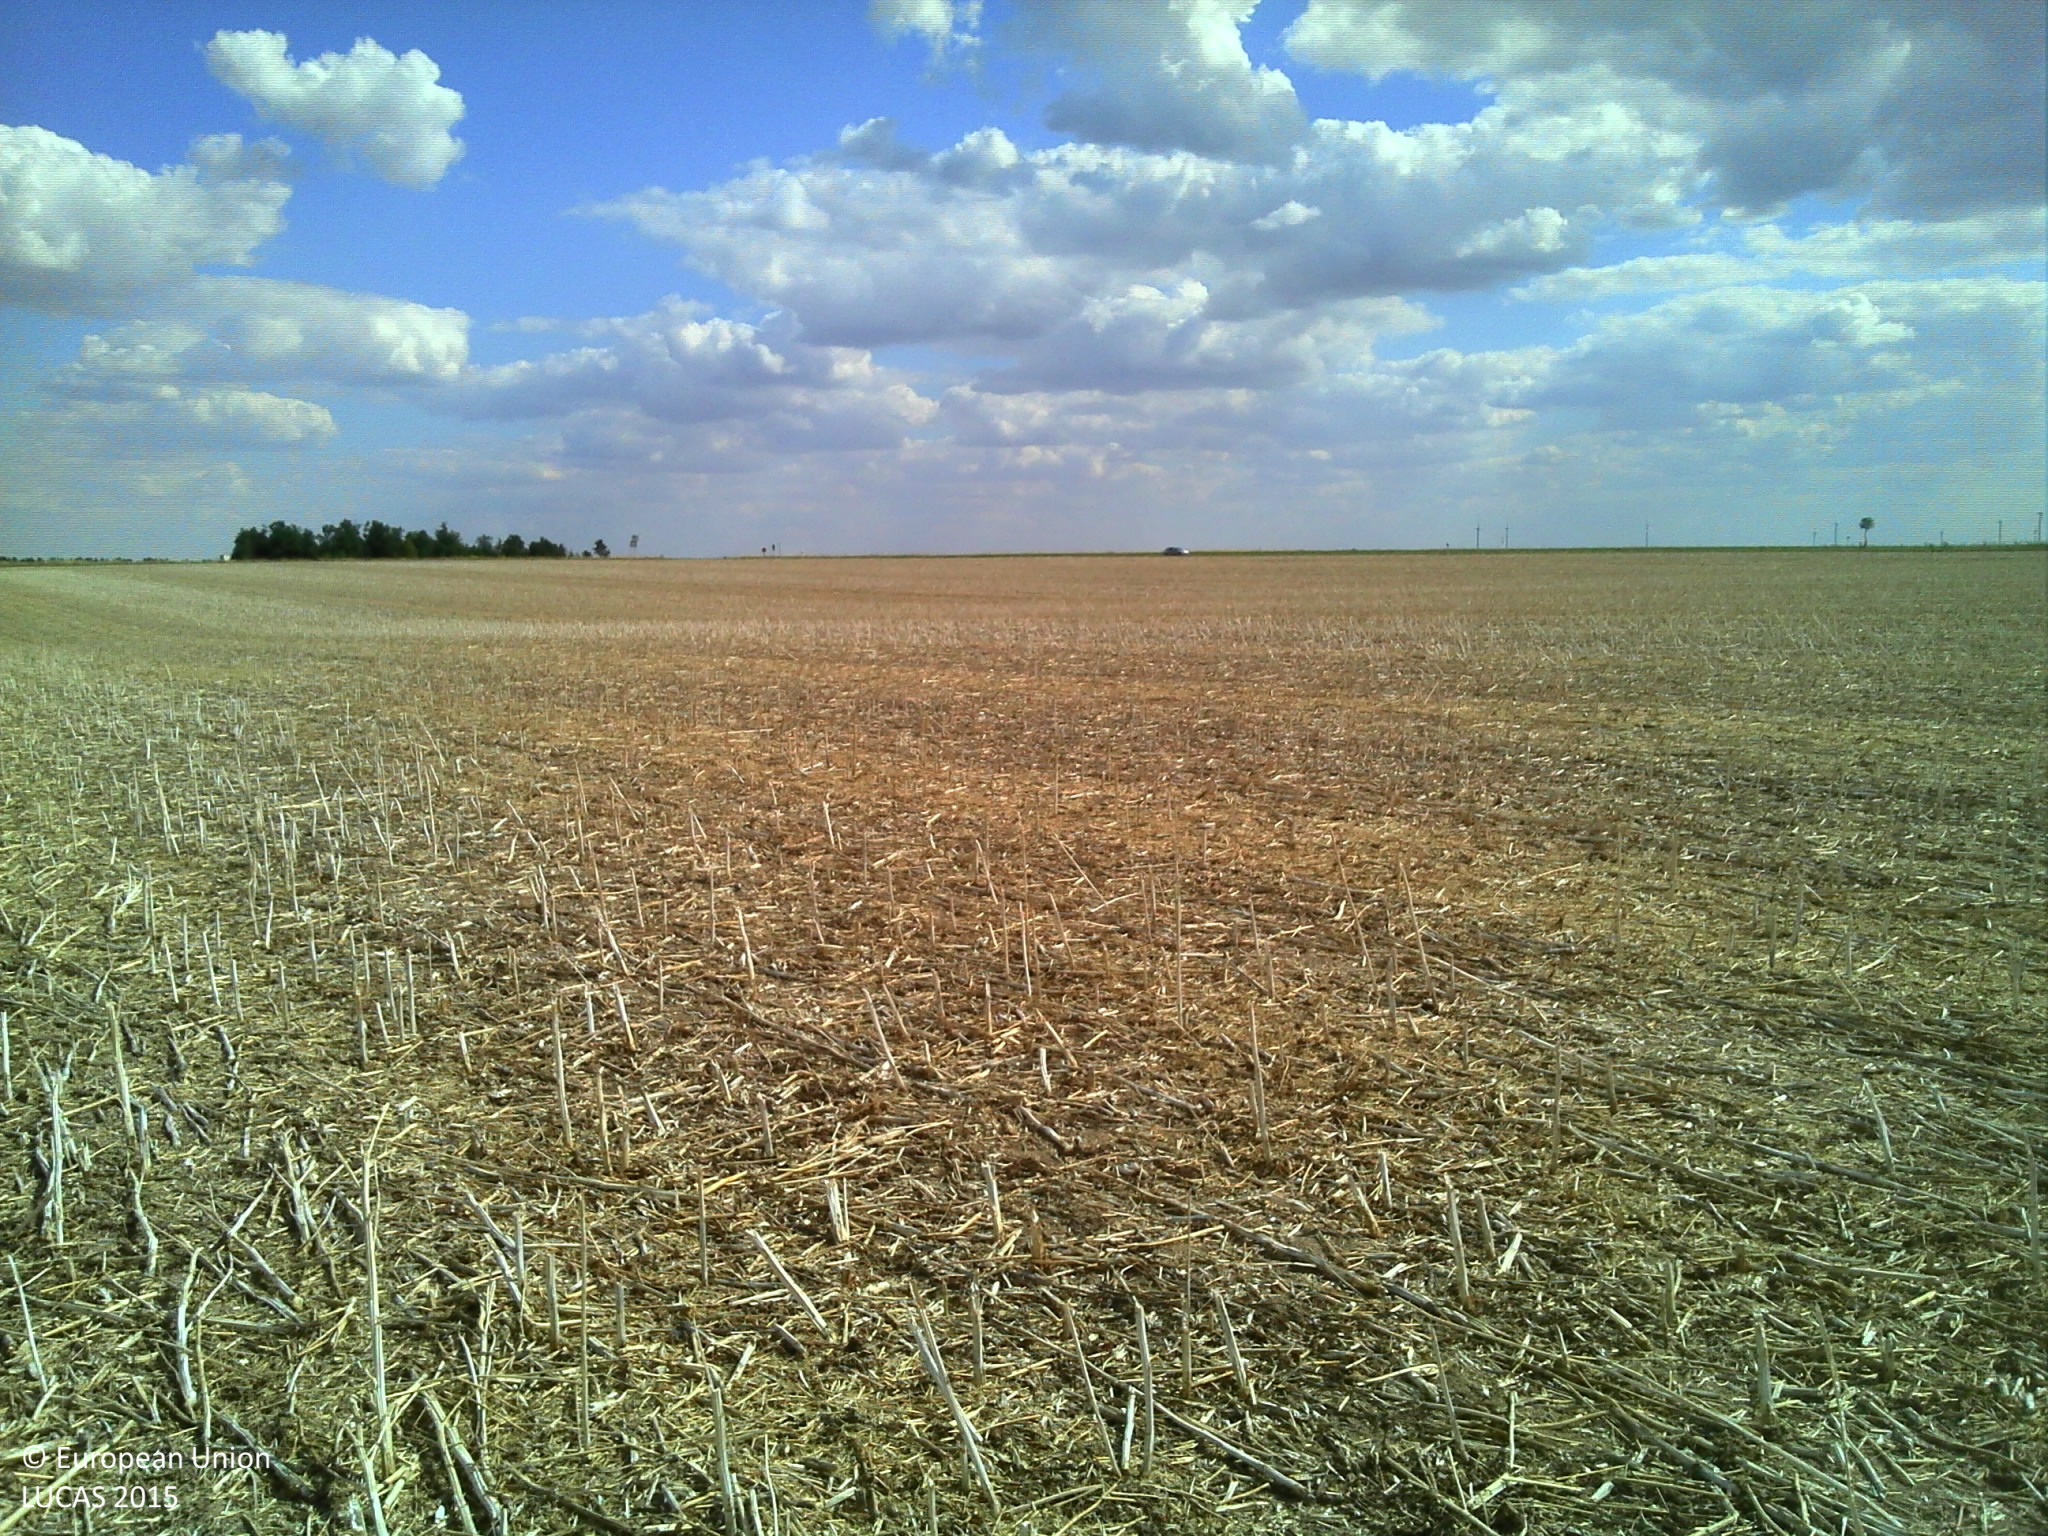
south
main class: Cropland
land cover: Rape and turnip rape
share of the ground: > 75 %
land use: Agriculture (excluding fallow land and kitchen gardens)
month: July
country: FR
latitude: 48.9156
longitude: 4.1417
